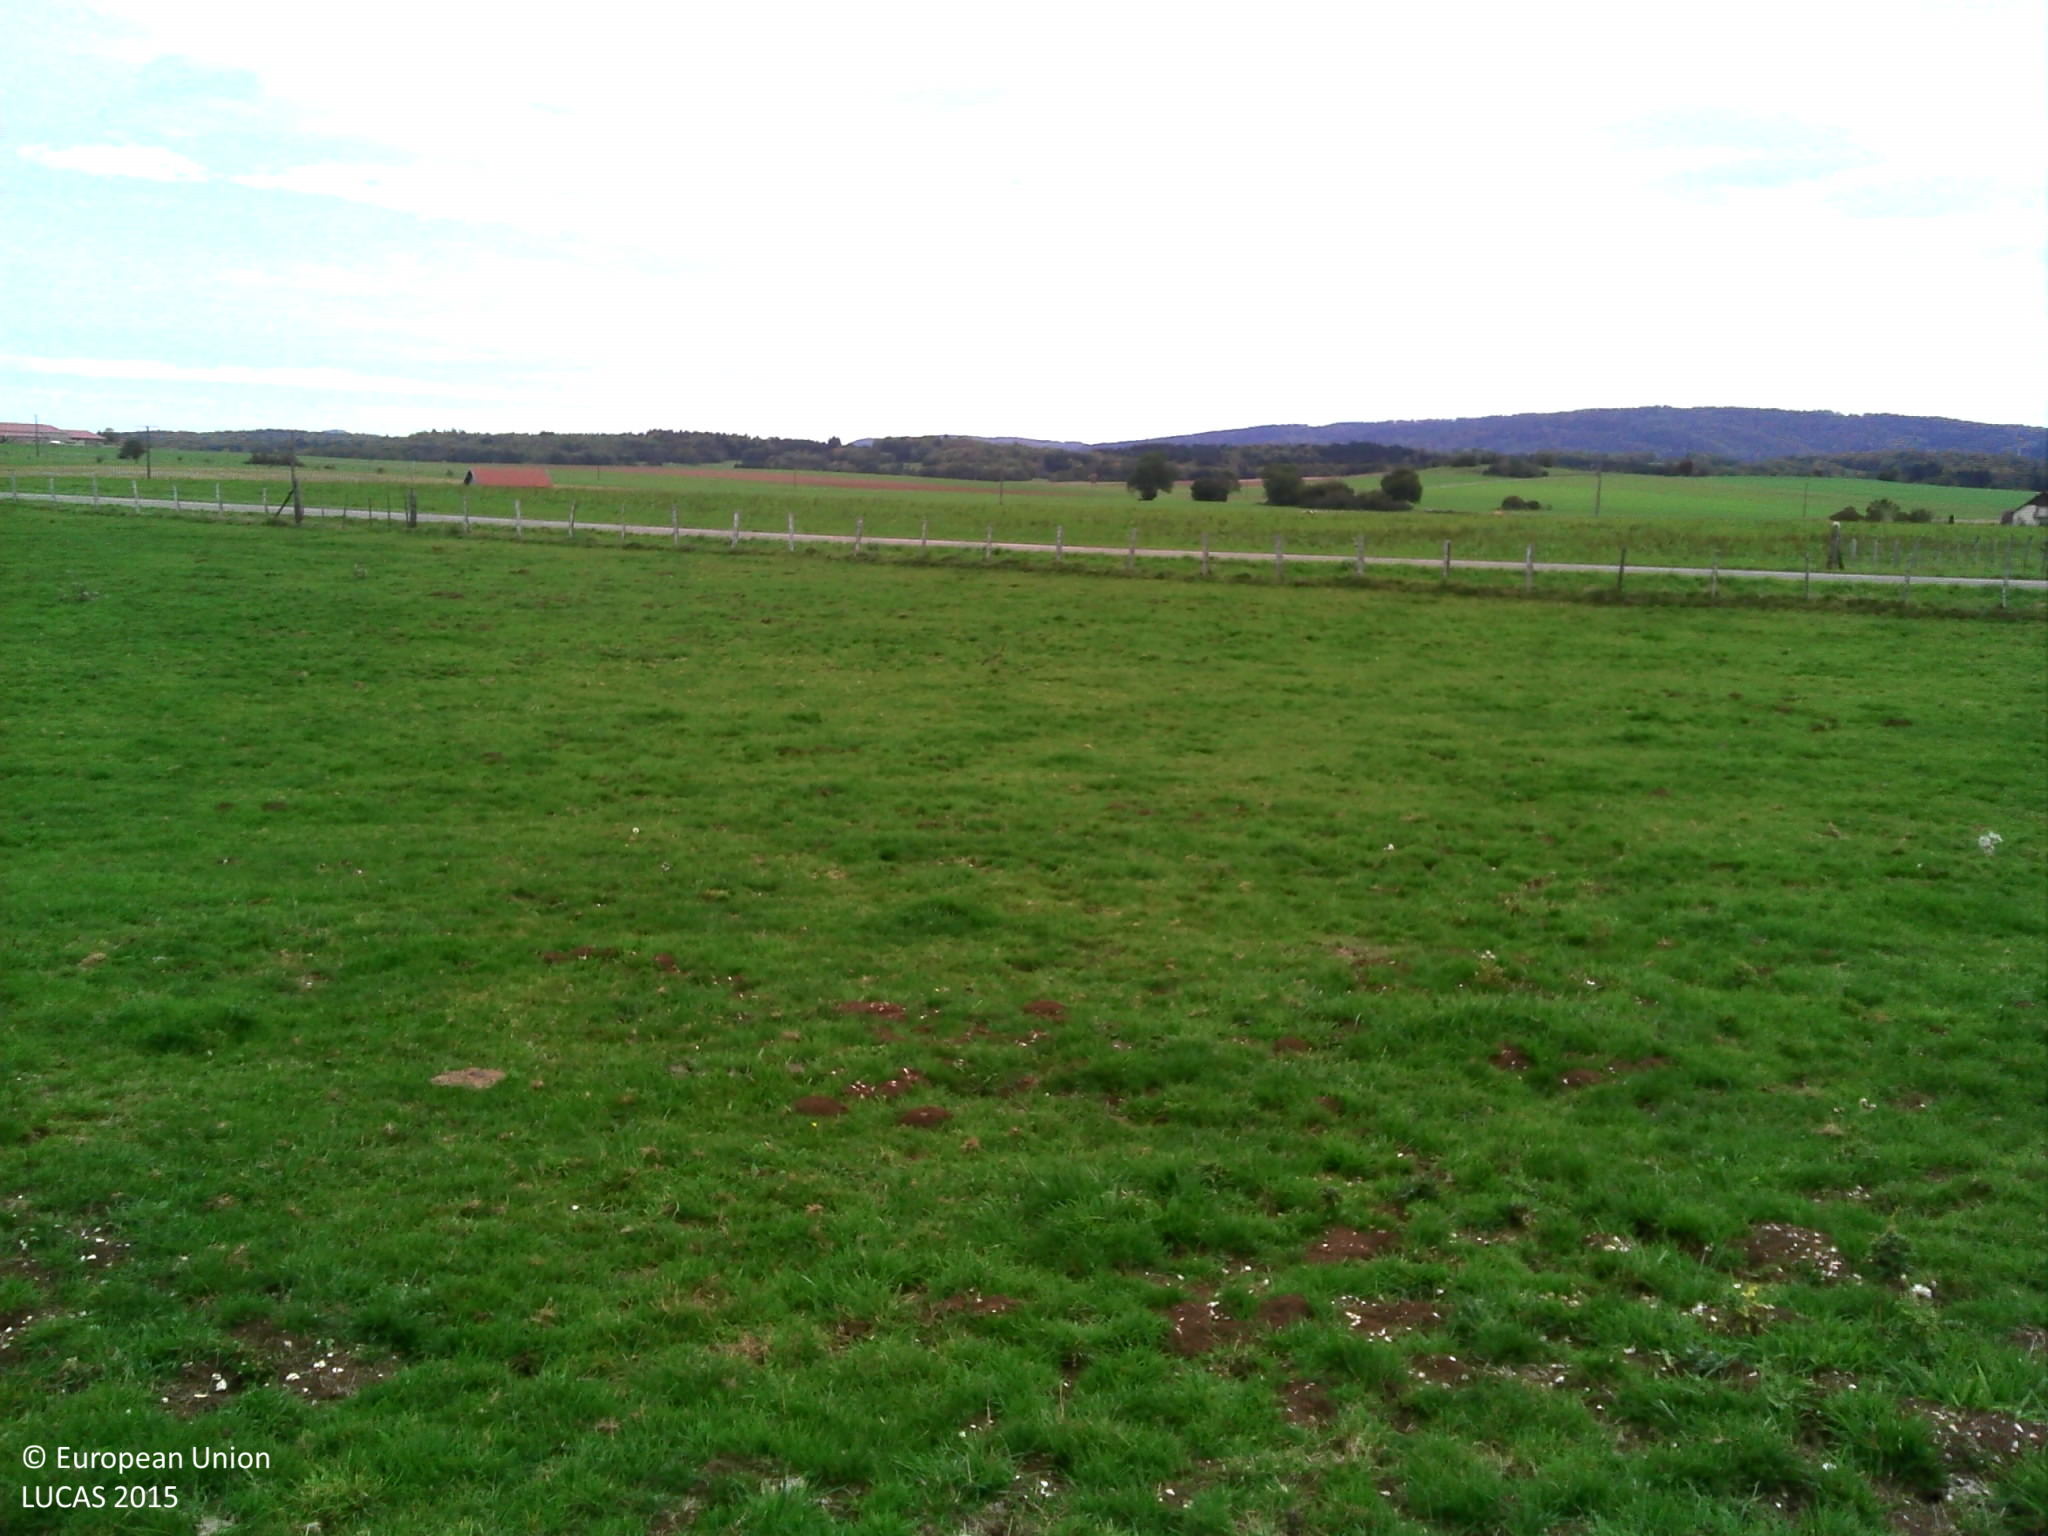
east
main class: Grassland
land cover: Grassland without tree/shrub cover
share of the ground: > 75 %
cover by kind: herbaceous plants 100 %
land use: Agriculture (excluding fallow land and kitchen gardens)
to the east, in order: Grassland without tree/shrub cover; Fences; Grass margins; Paved roads, cycling and walking lanes; Grassland without tree/shrub cover
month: October
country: FR
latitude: 47.0390
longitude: 6.1460
